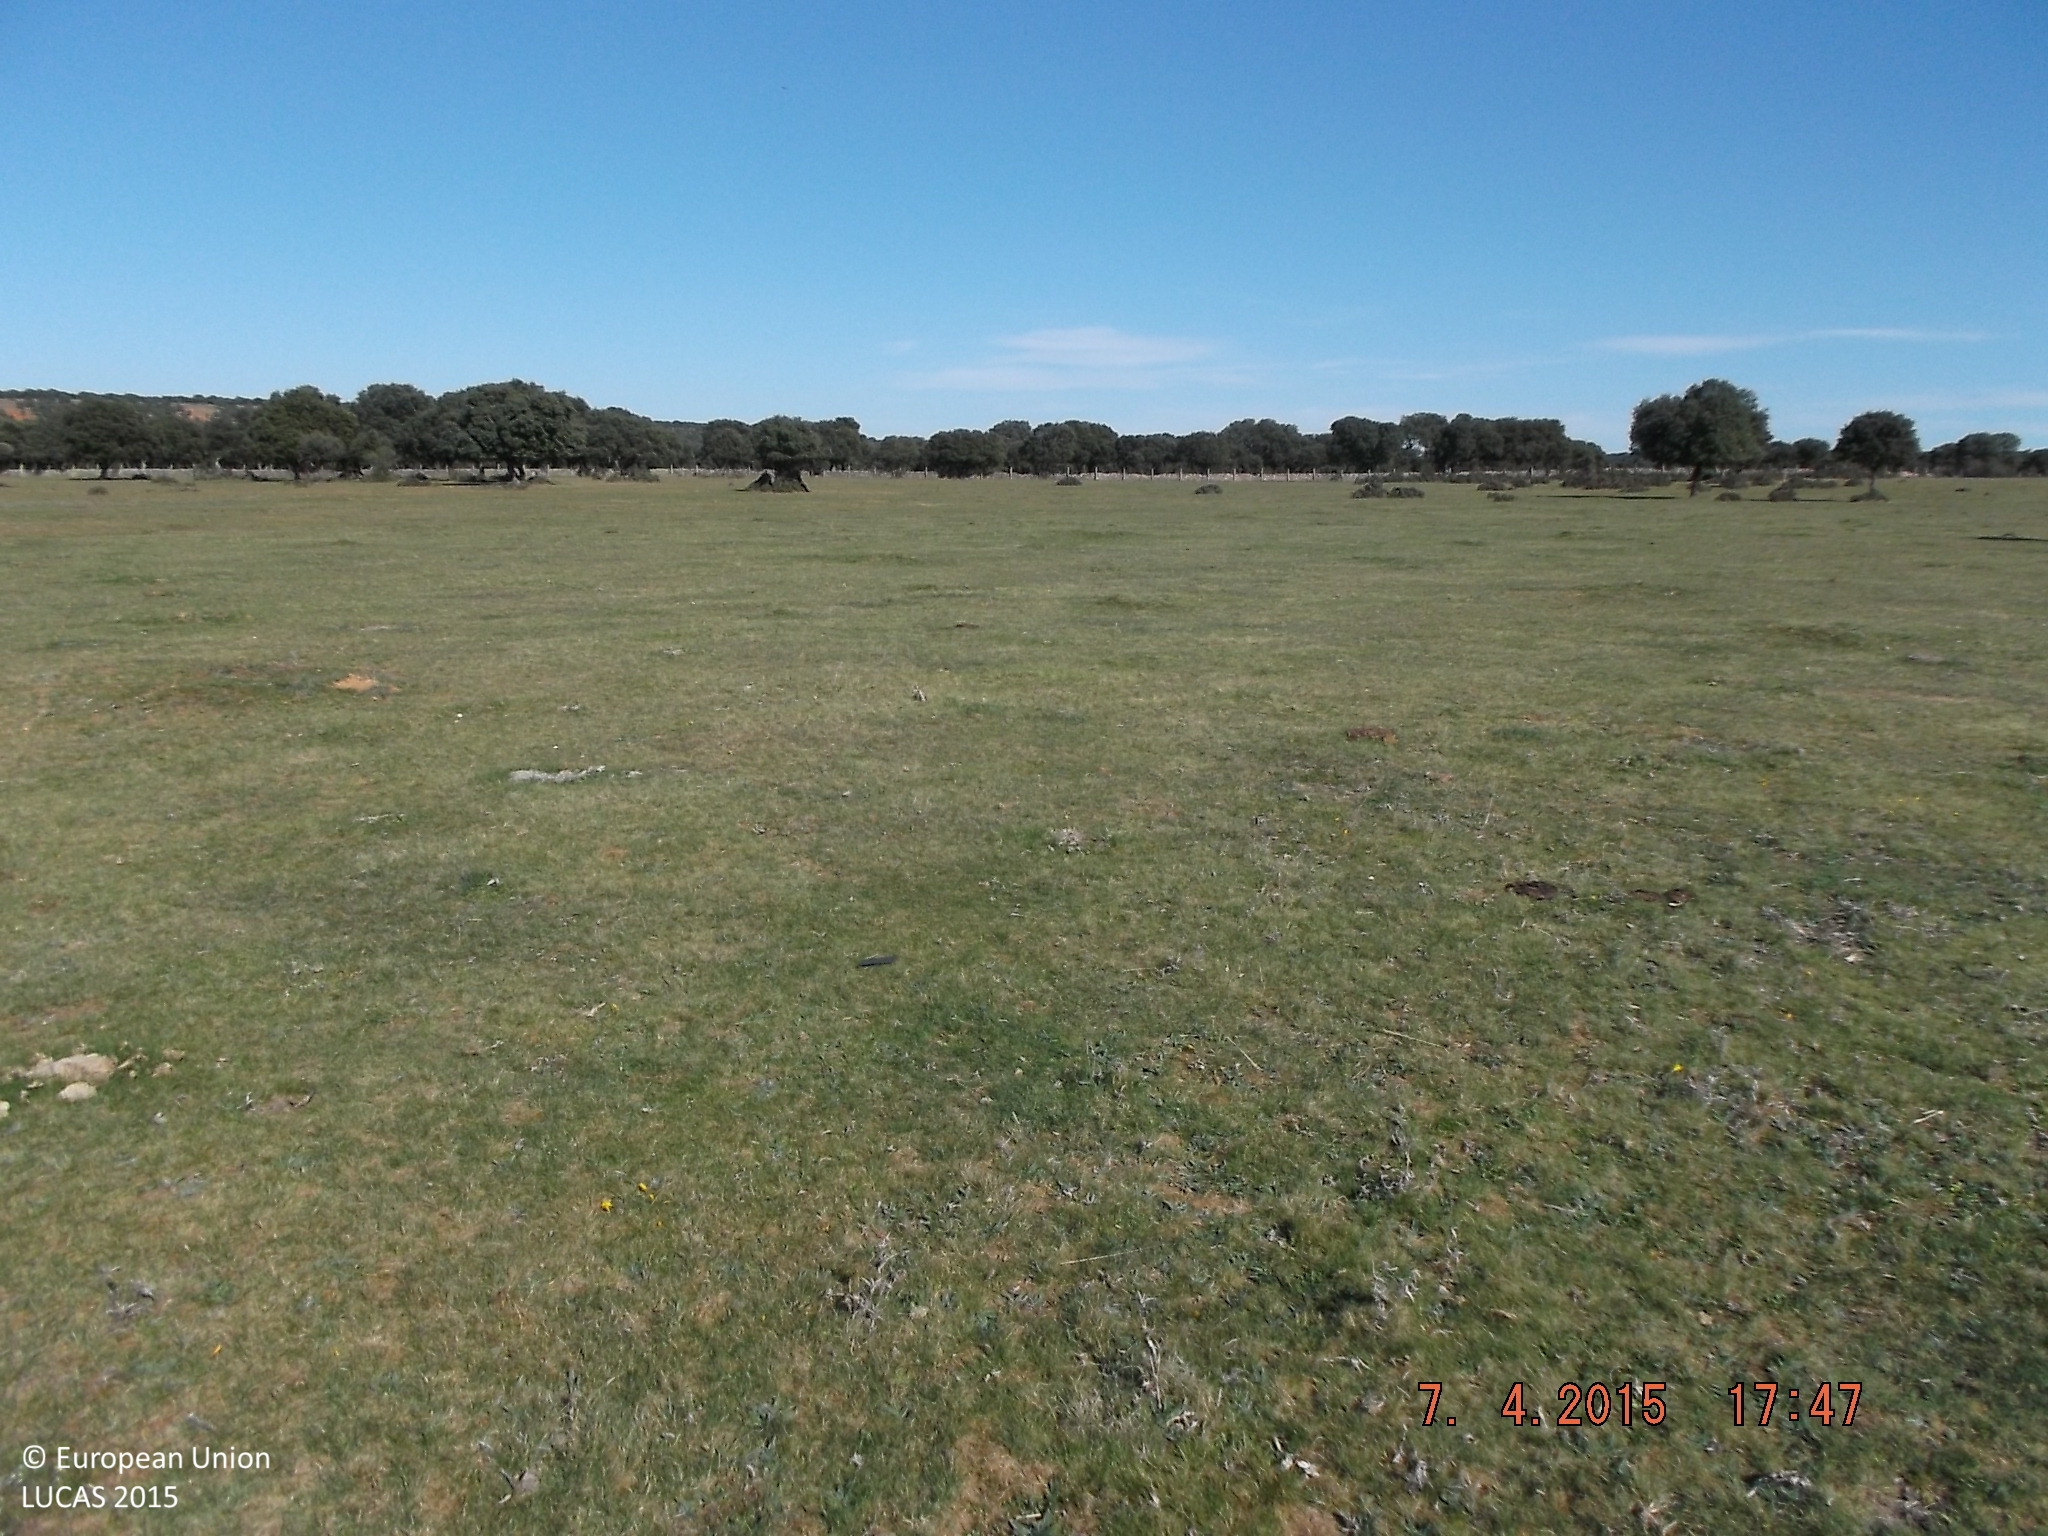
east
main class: Grassland
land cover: Grassland without tree/shrub cover
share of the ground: > 75 %
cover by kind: herbaceous plants 100 %
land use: Agriculture (excluding fallow land and kitchen gardens)
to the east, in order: Grassland without tree/shrub cover; Tracks; Grass margins; Dry stone walls; Grassland without tree/shrub cover; Broadleaved woodland
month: April
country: ES
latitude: 40.8139
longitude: -5.9308
